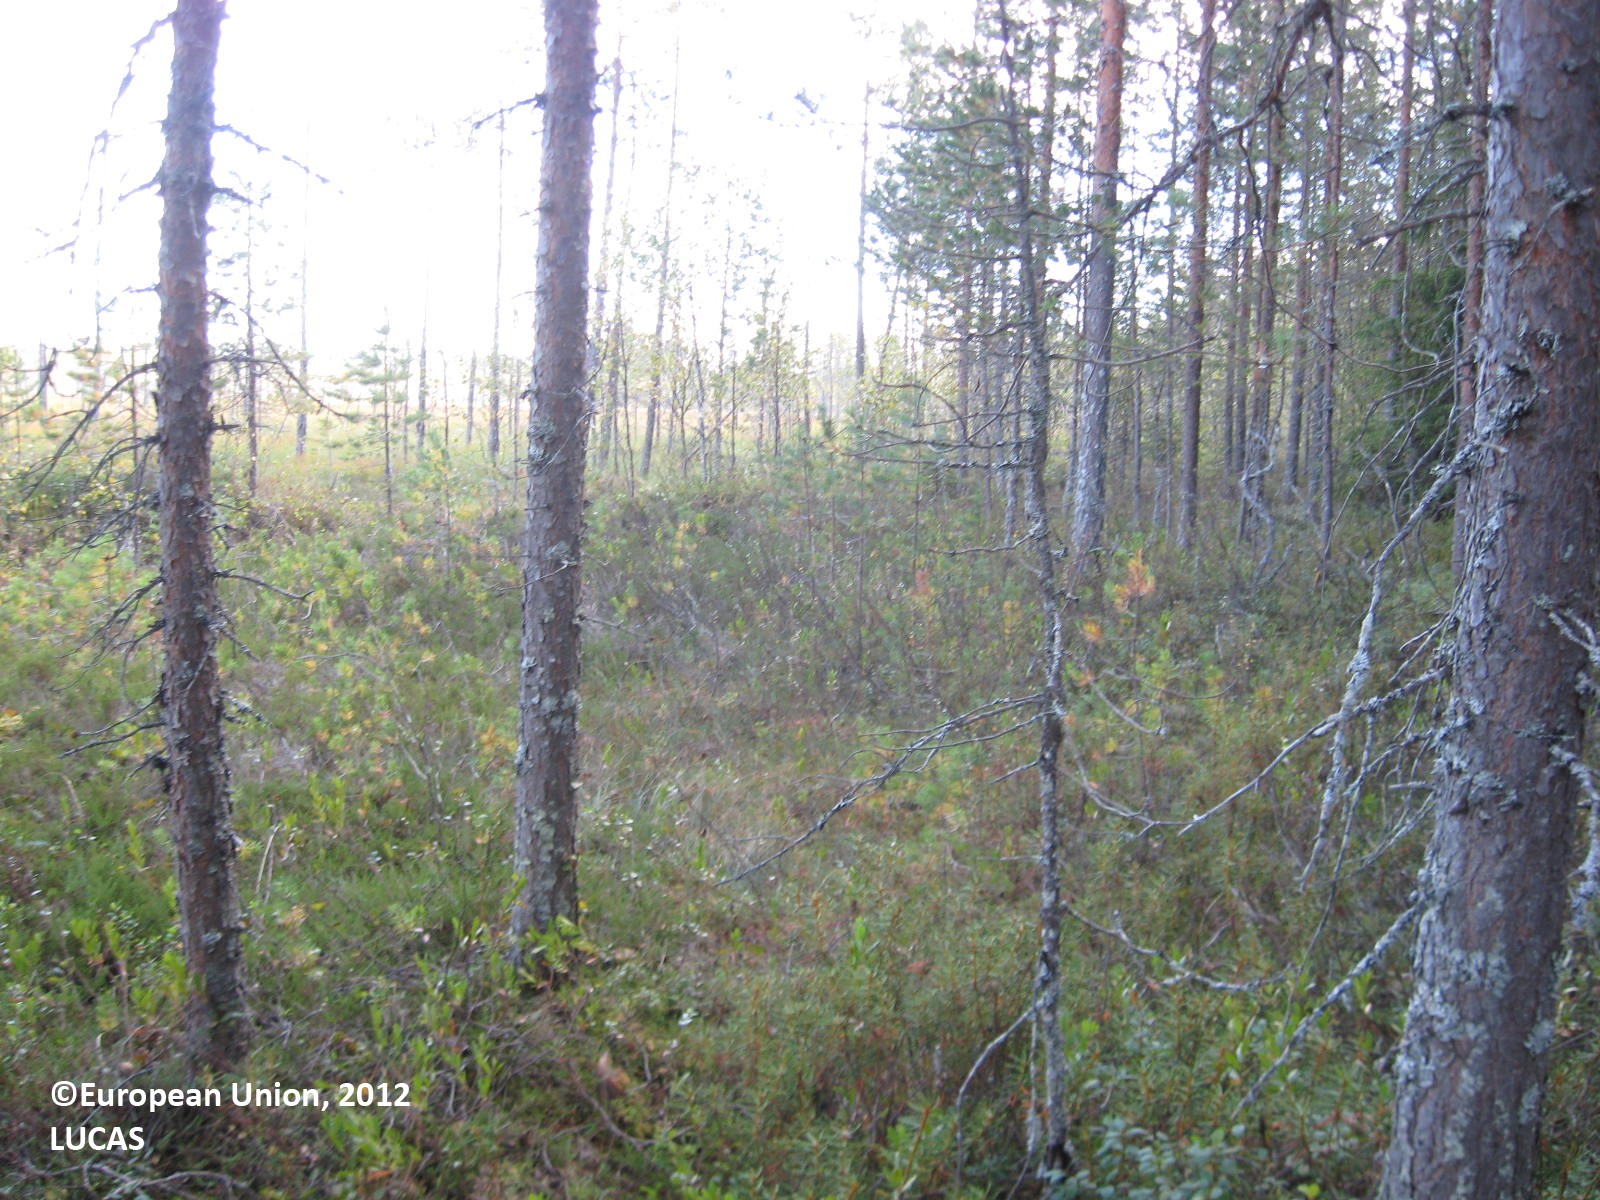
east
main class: Woodland
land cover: Pine dominated coniferous woodland
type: boreal forest
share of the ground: > 75 %
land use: Forestry
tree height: > 5 m
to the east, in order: Pine dominated coniferous woodland; Ditches and canals; Pine dominated coniferous woodland; Peatbogs; Pine dominated coniferous woodland; Peatbogs
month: August
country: FI
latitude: 63.7505
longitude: 29.9188
